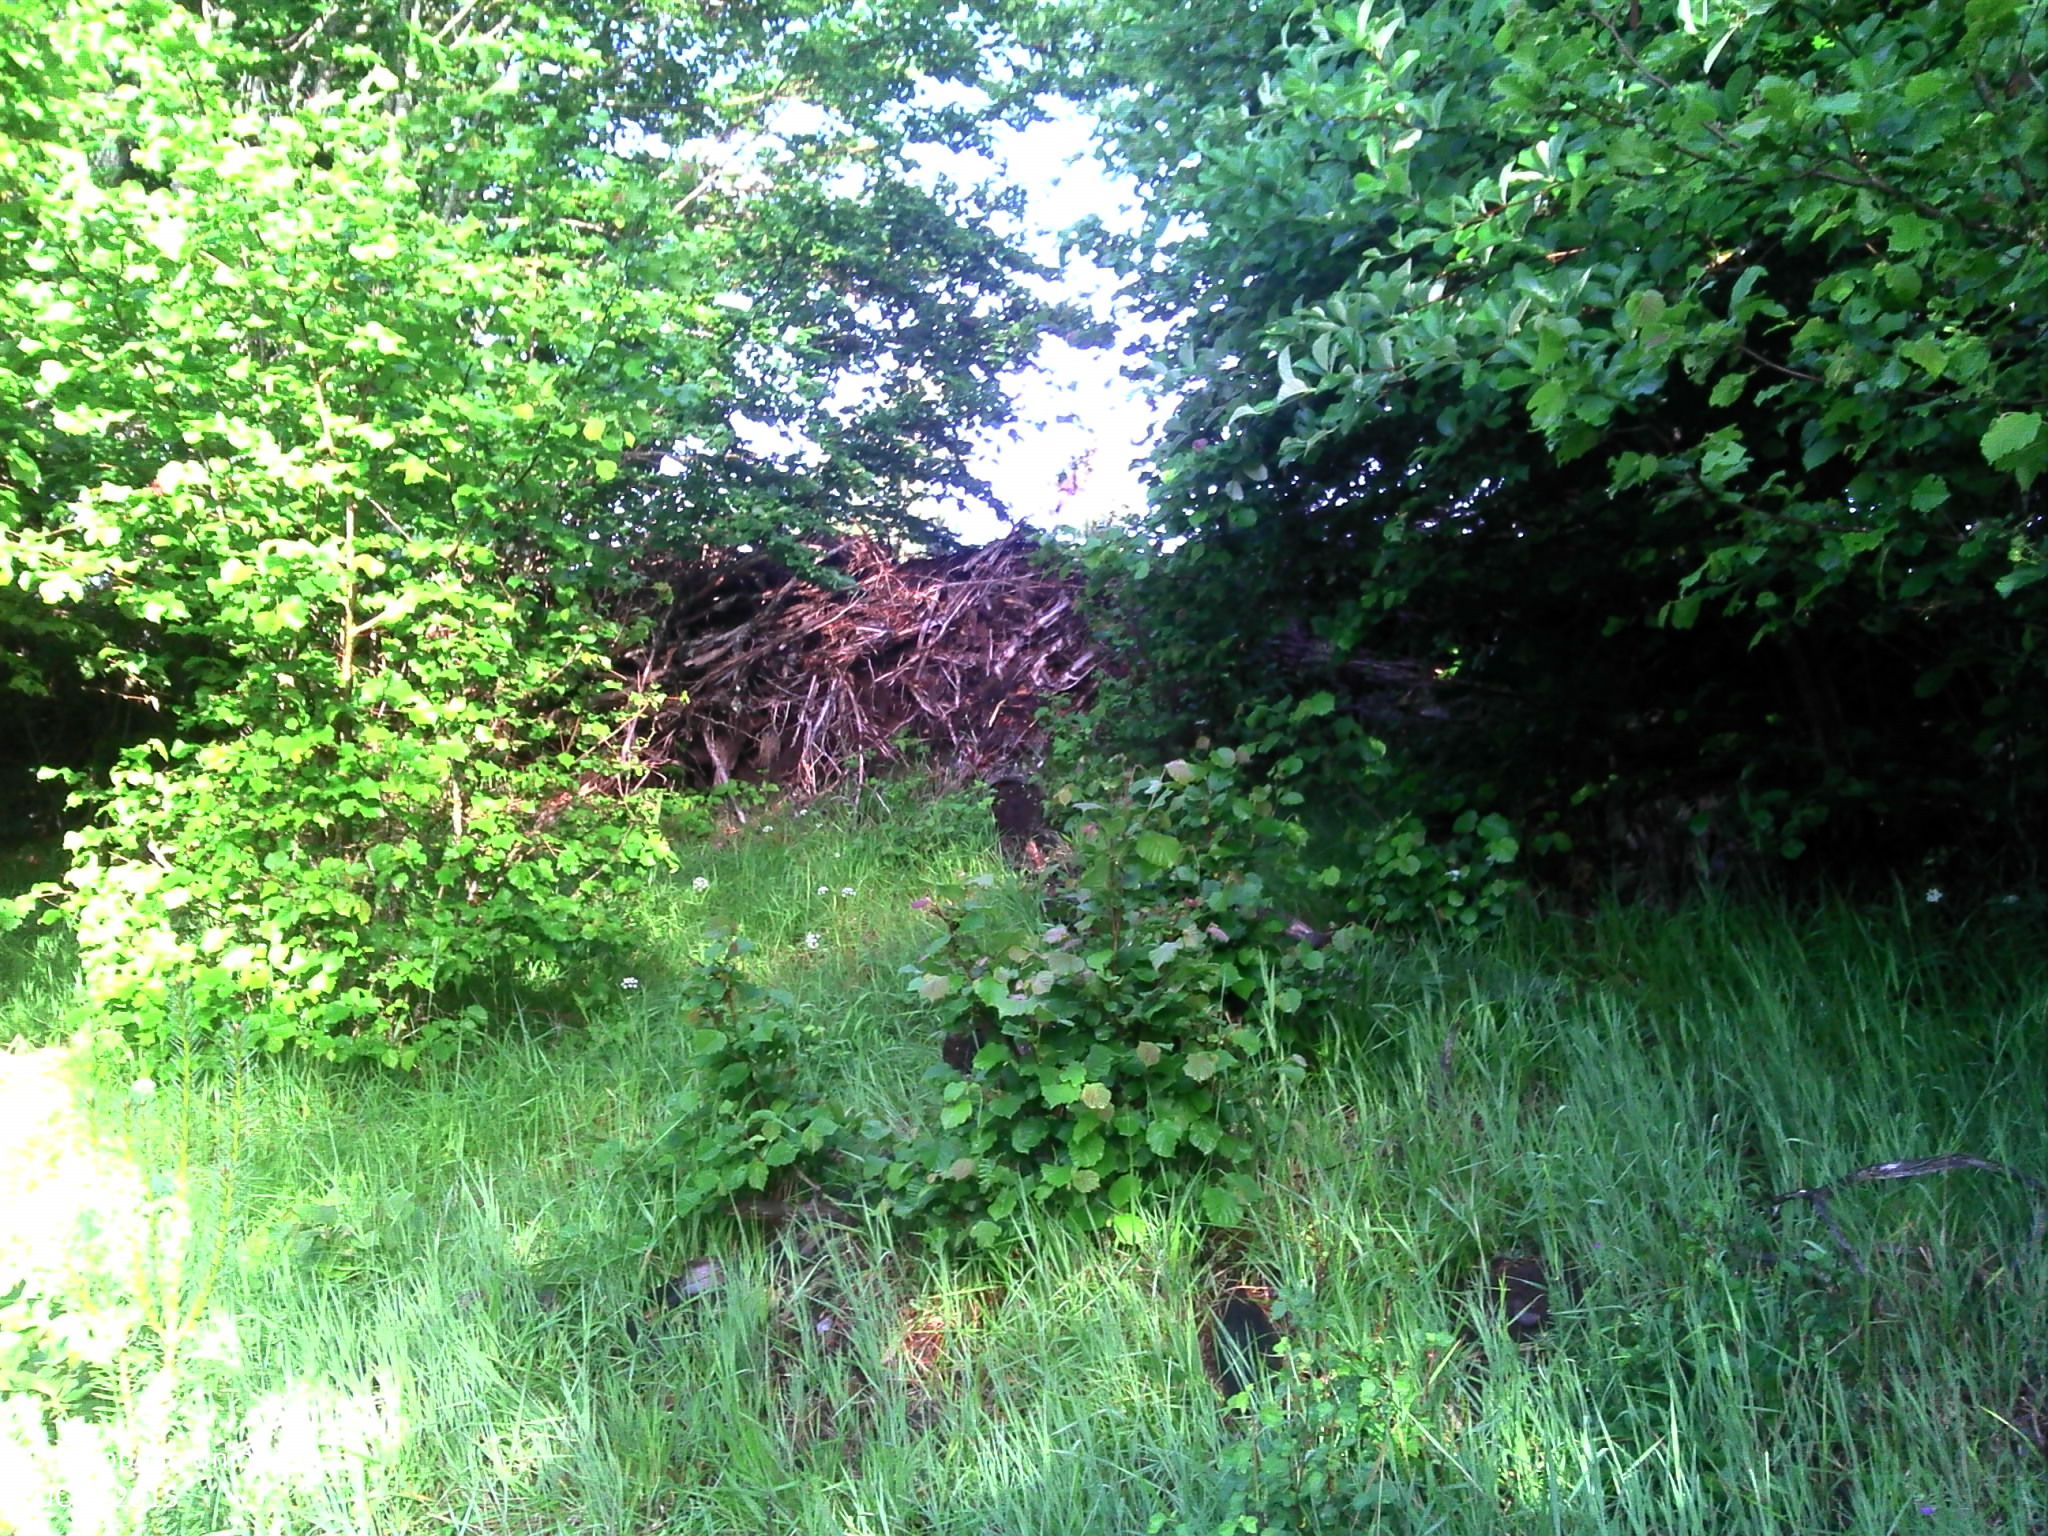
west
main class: Woodland
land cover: Pine dominated mixed woodland
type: alpine coniferous forest
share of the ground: > 75 %
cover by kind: broadleaved forest trees 50 %, coniferous forest trees 20 %, herbaceous plants 20 %, shrubs 10 %
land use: Forestry
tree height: > 5 m
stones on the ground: 10 - 25 %
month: June
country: FR
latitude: 45.1757
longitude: 2.9135
